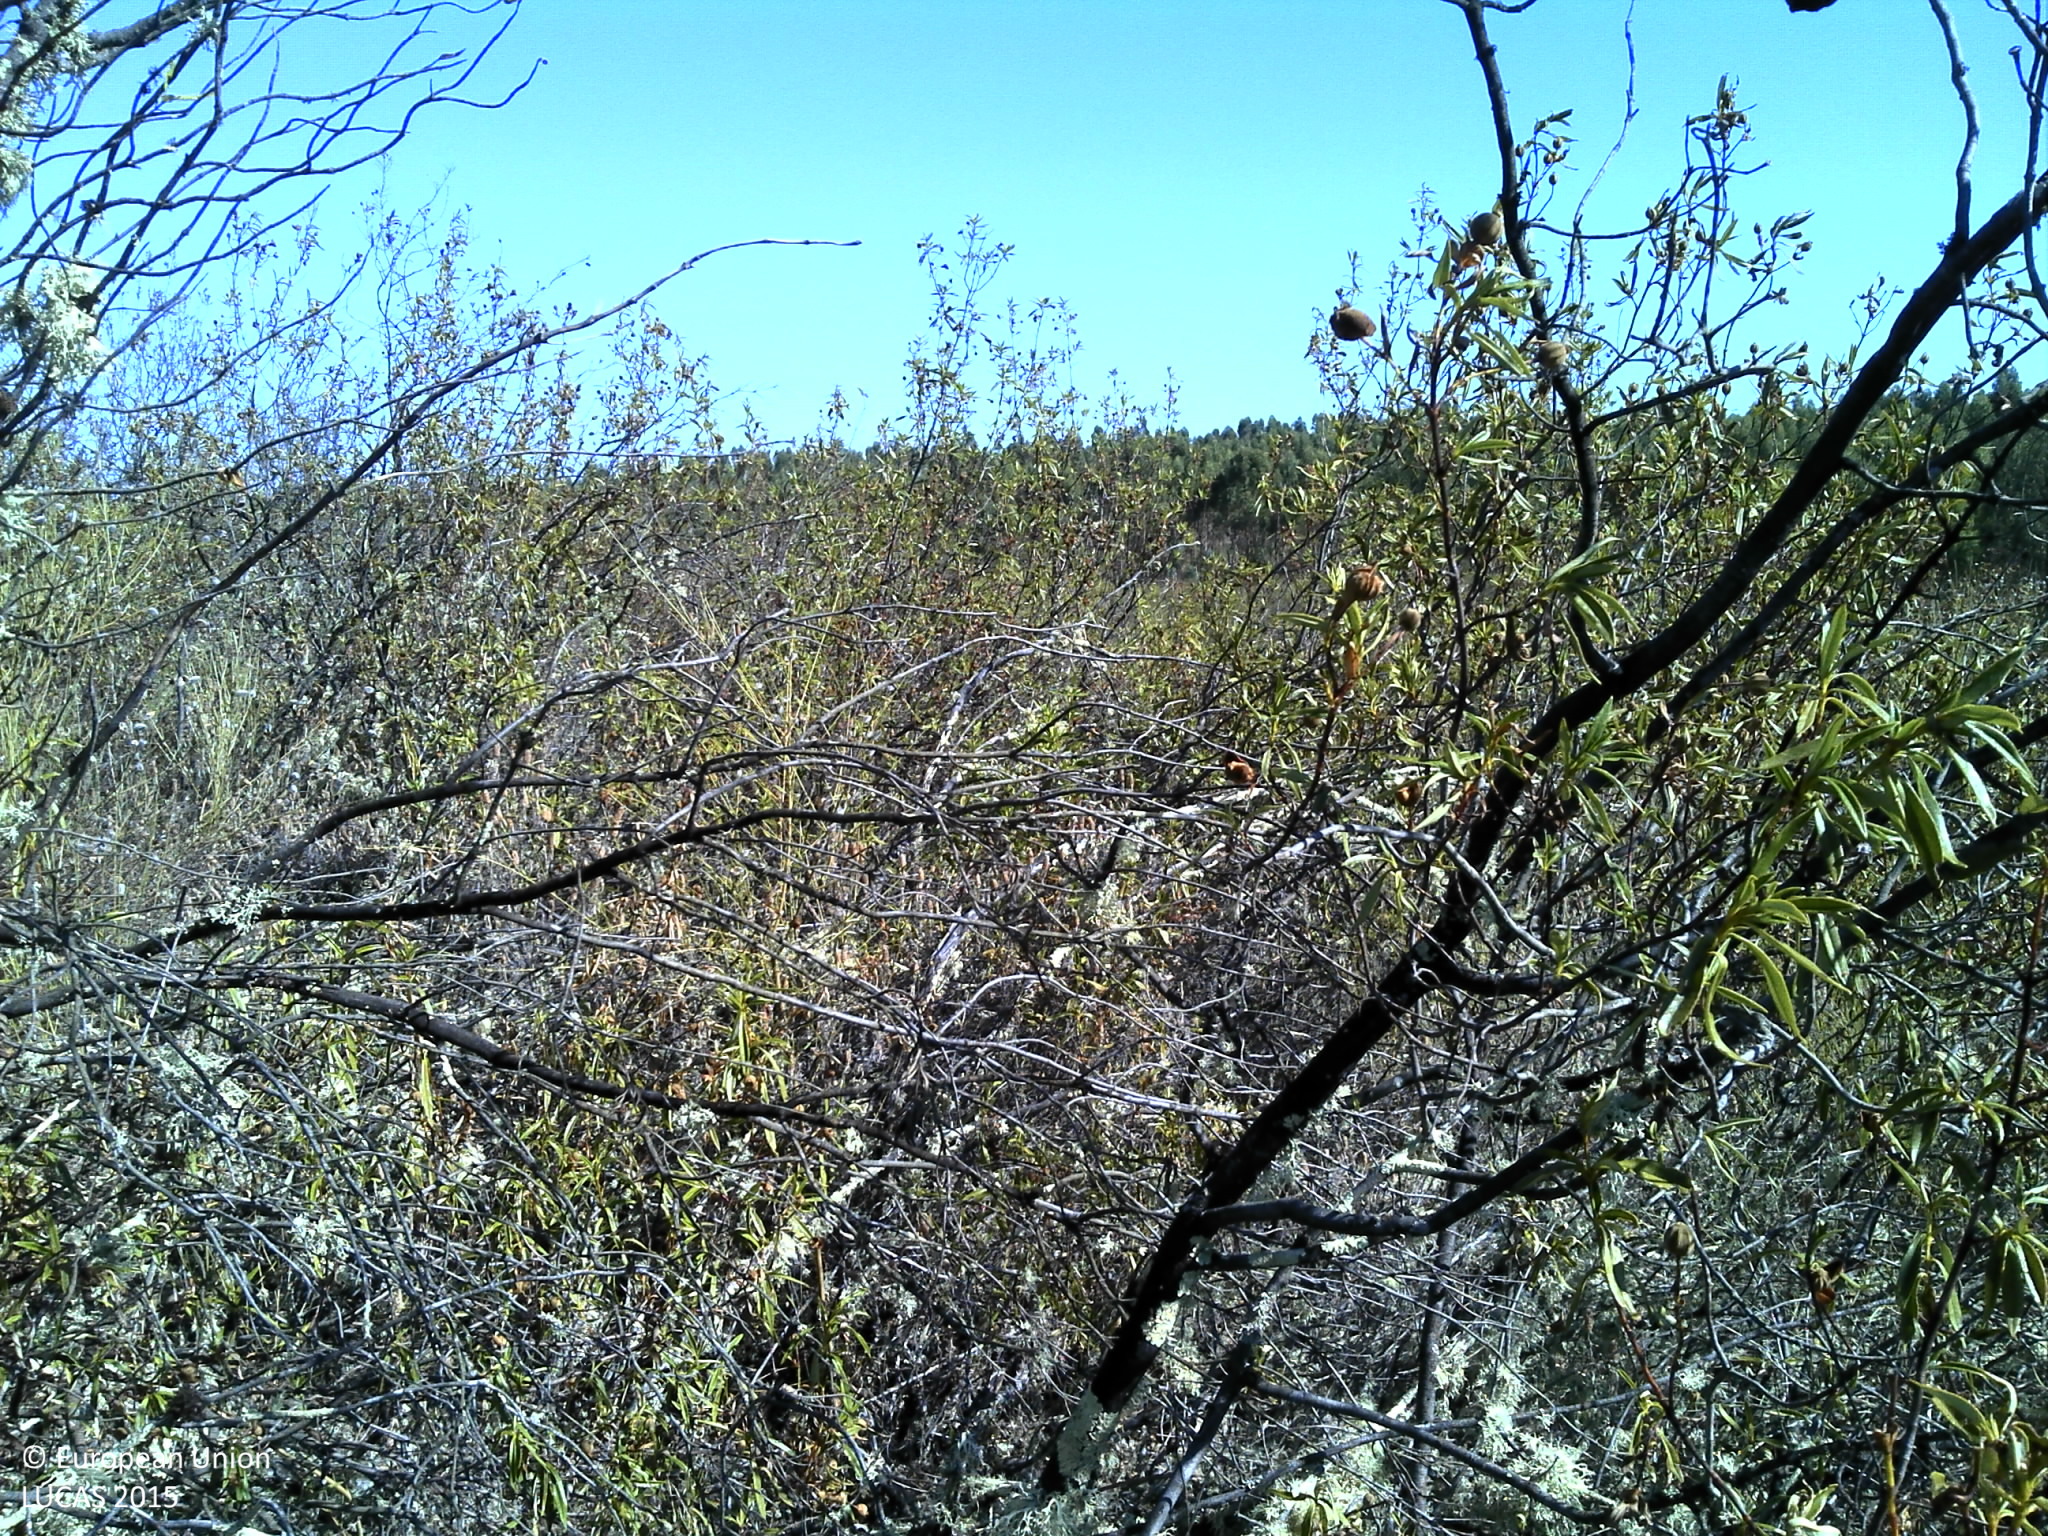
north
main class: Shrubland
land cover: Shrubland without tree cover
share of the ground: > 75 %
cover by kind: shrubs 100 %
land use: Semi-natural and natural areas not in use
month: August
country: PT
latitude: 39.5692
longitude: -7.6879
